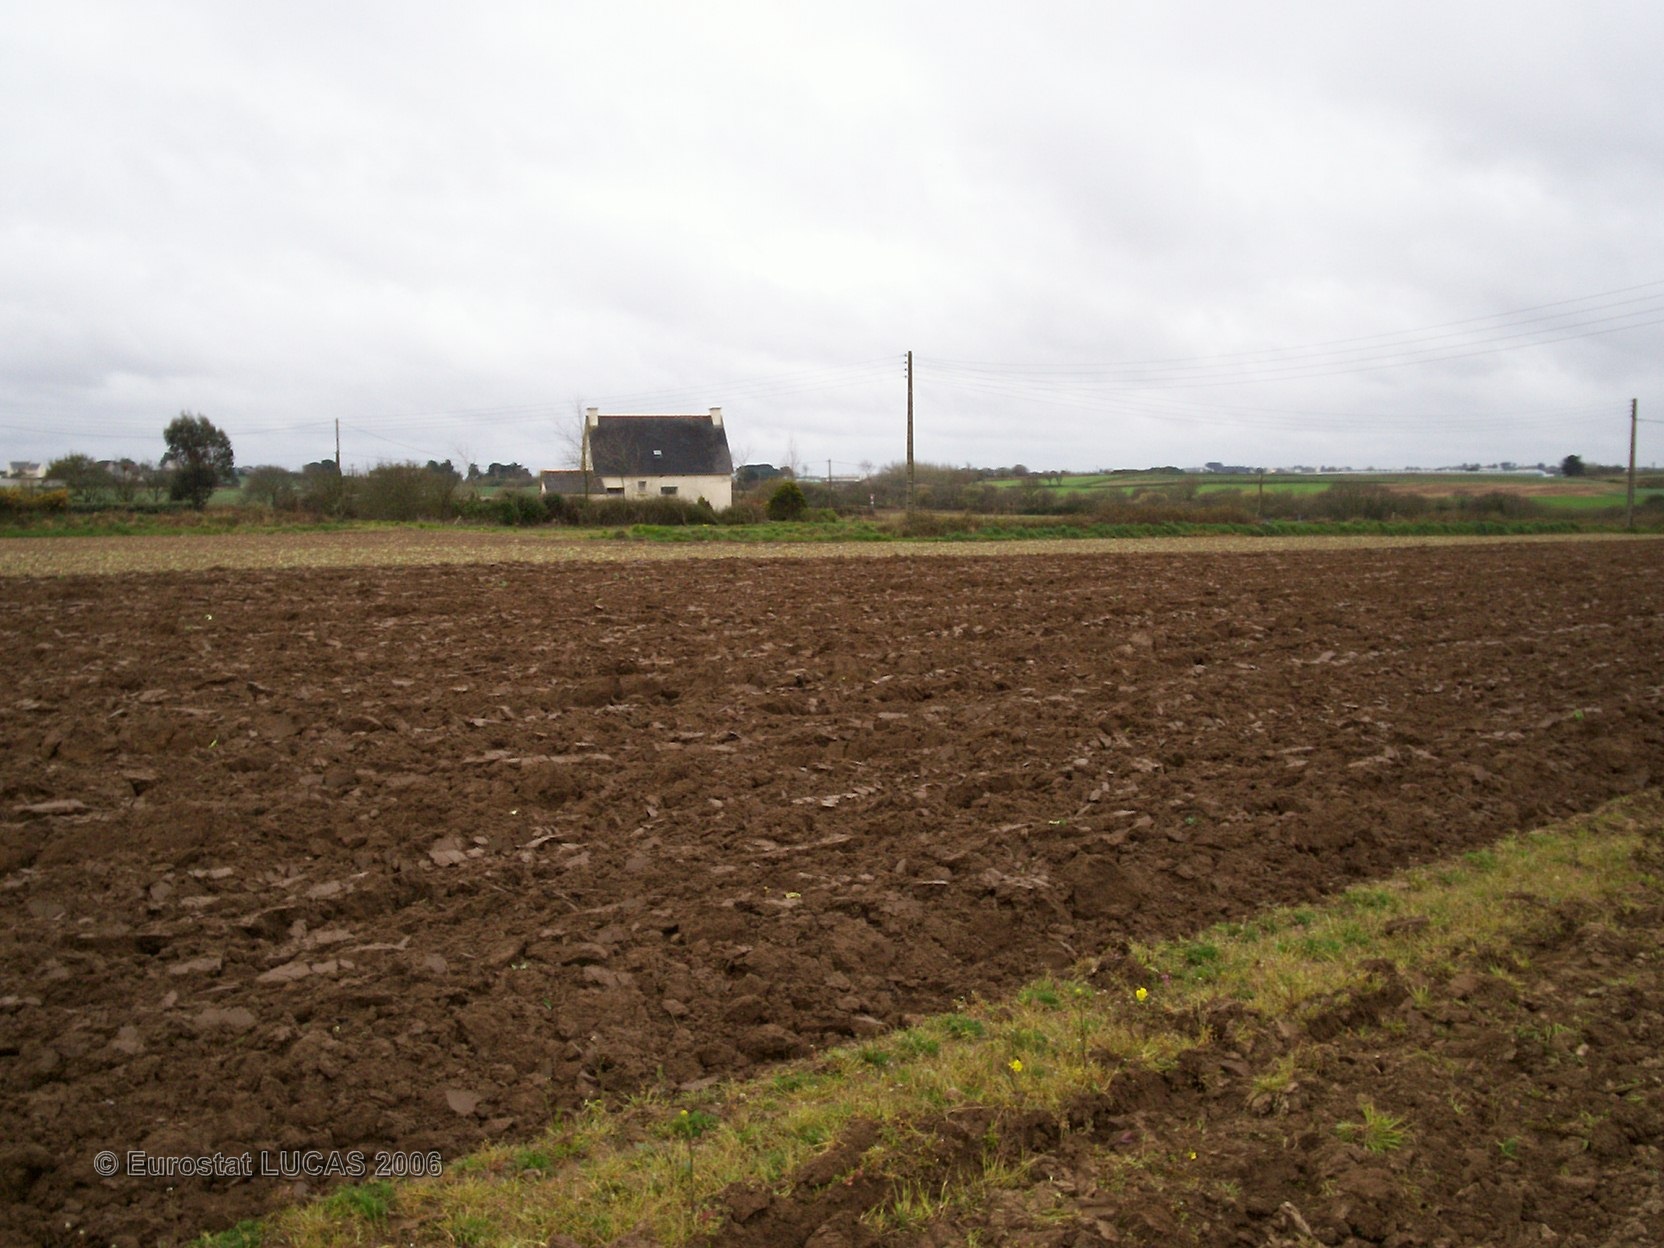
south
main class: Cropland
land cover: Other fresh vegetables
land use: Agriculture (excluding fallow land and kitchen gardens)
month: April
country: FR
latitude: 48.6326
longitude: -4.0529
